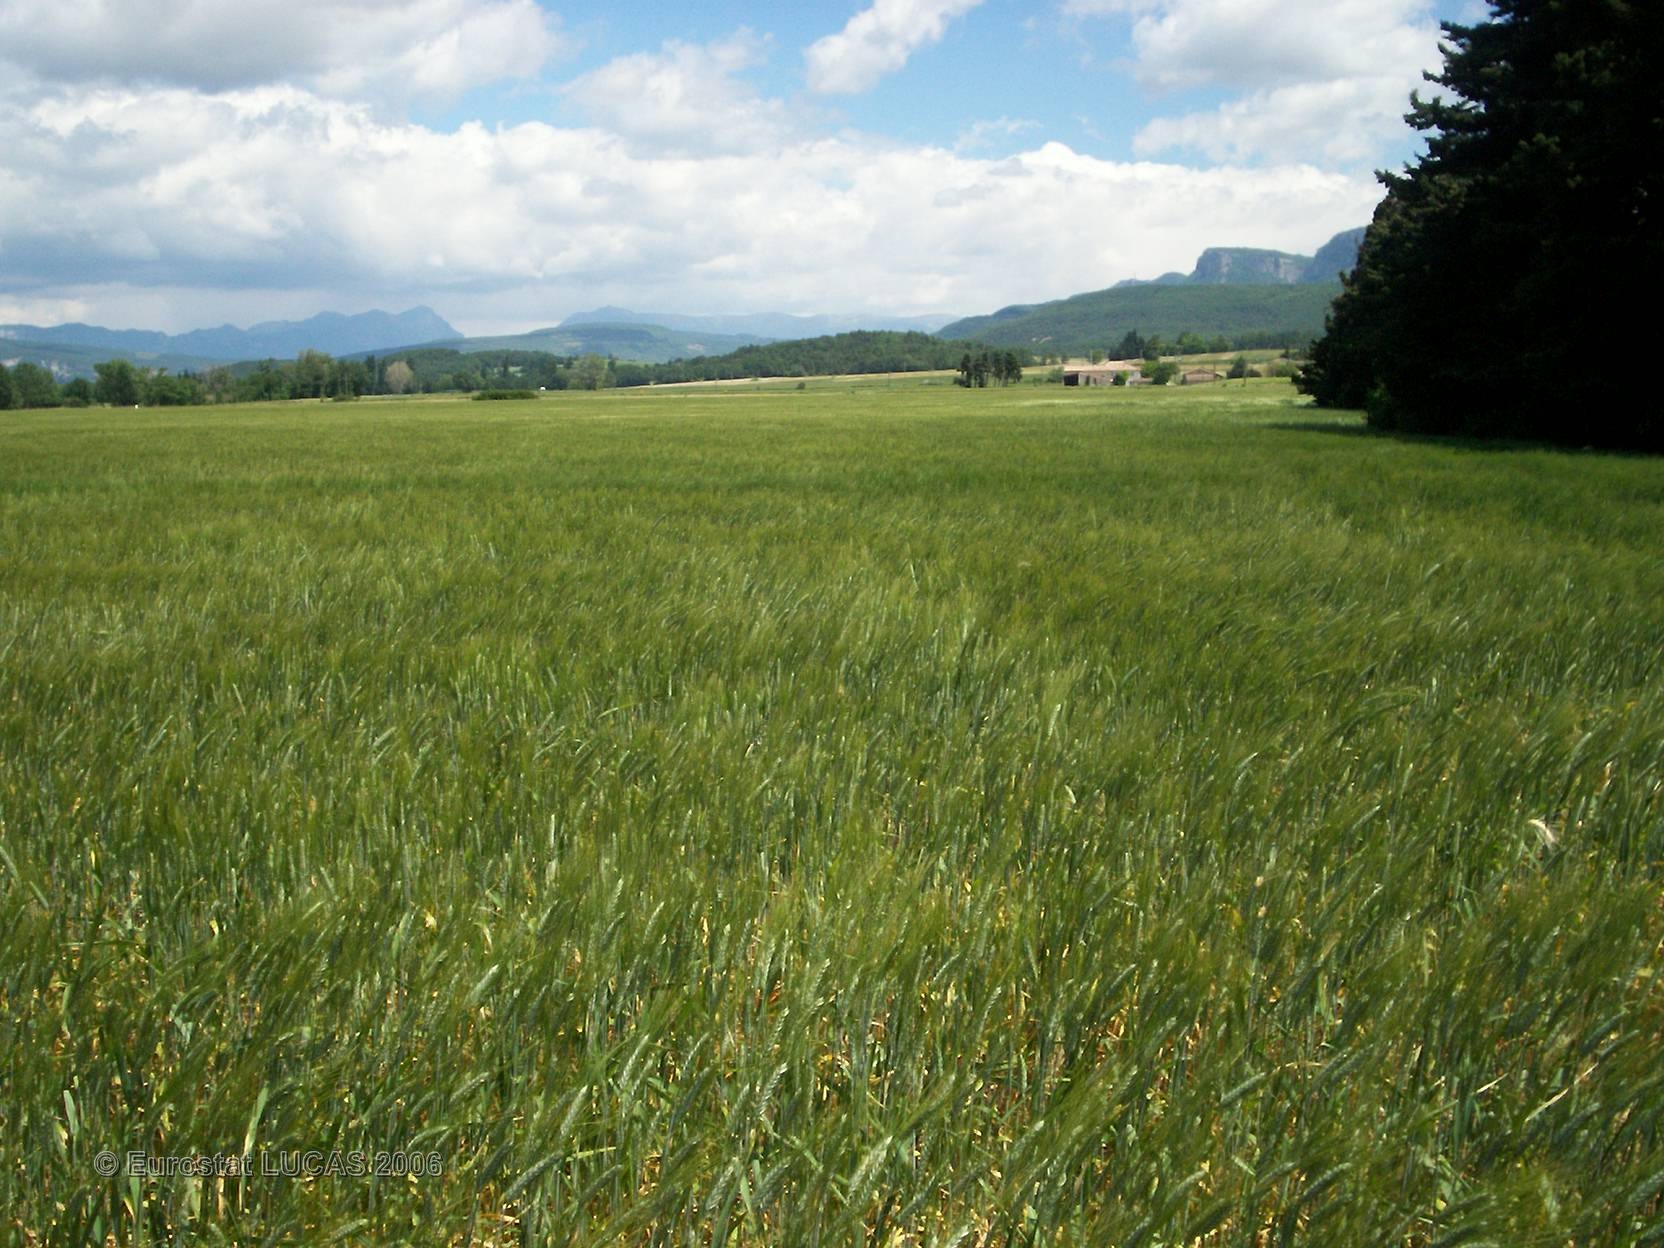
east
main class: Cropland
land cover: Durum wheat
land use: Agriculture (excluding fallow land and kitchen gardens)
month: May
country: FR
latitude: 44.5700
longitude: 4.9322
